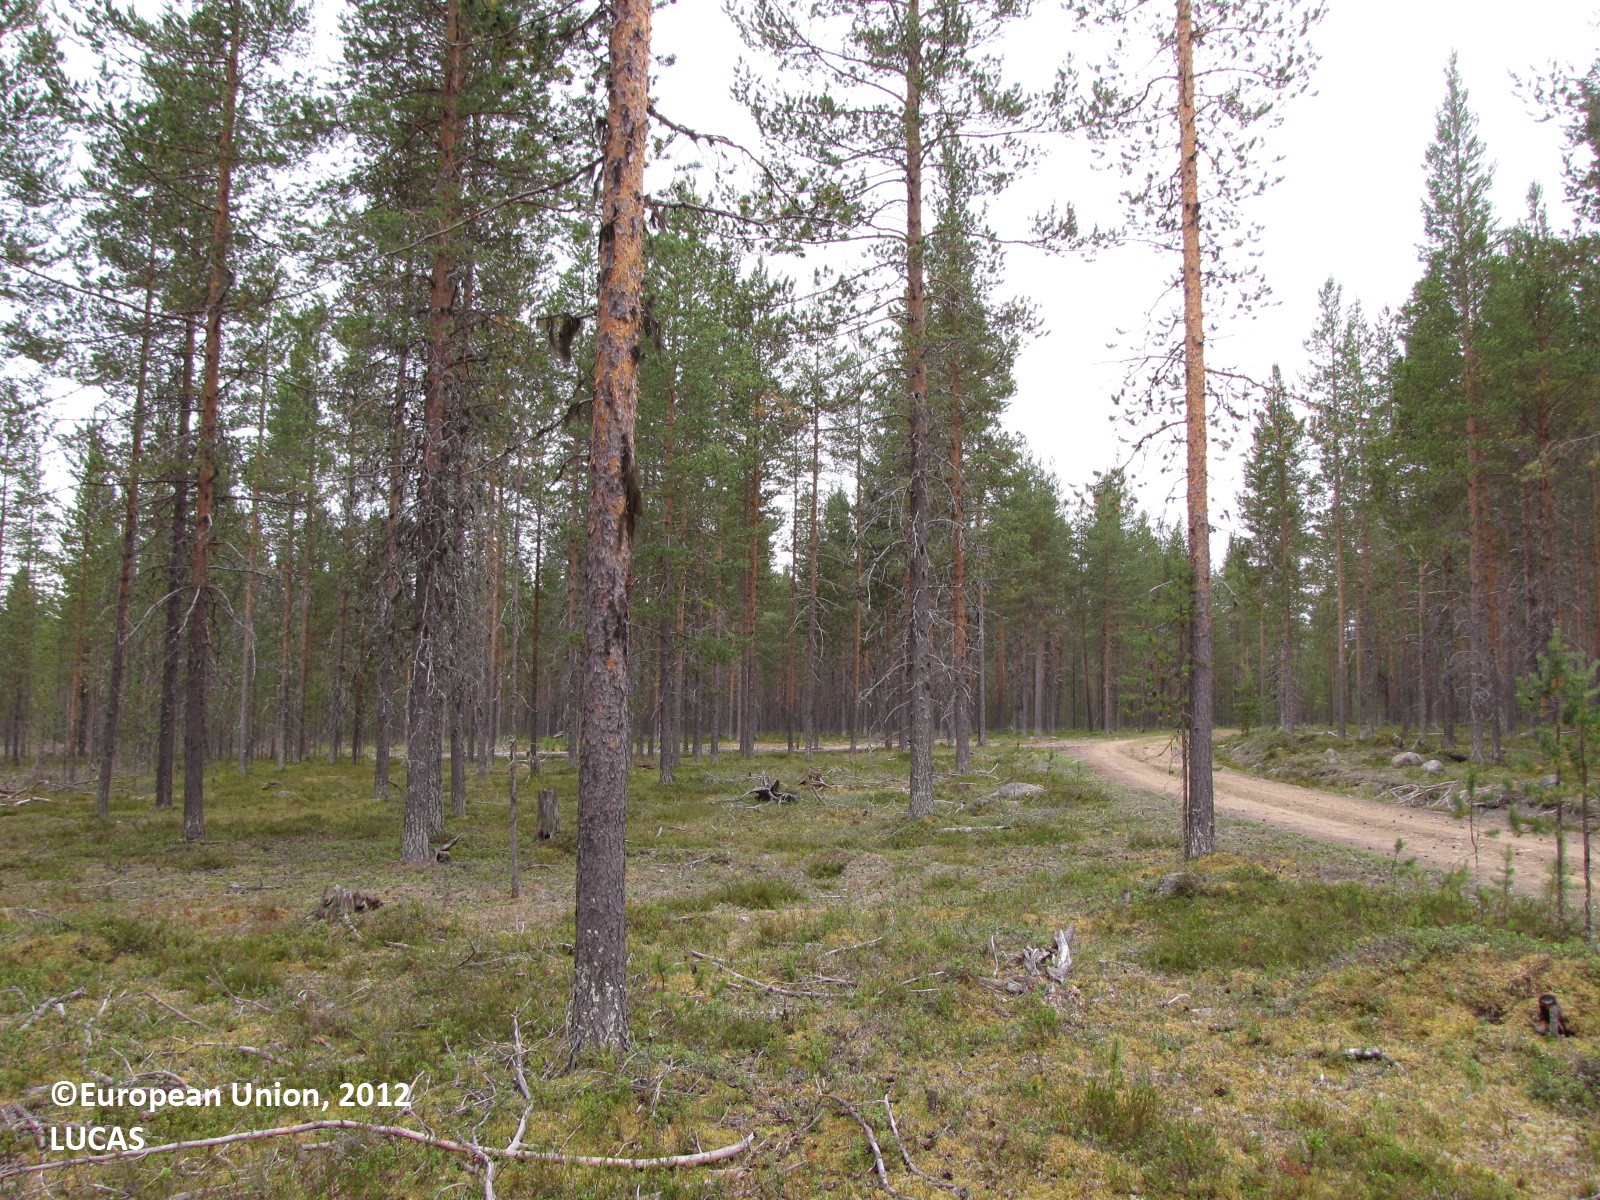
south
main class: Woodland
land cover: Pine dominated coniferous woodland
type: boreal forest
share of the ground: 25 - 50 %
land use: Forestry
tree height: > 5 m
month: August
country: FI
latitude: 67.0502
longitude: 25.1480
